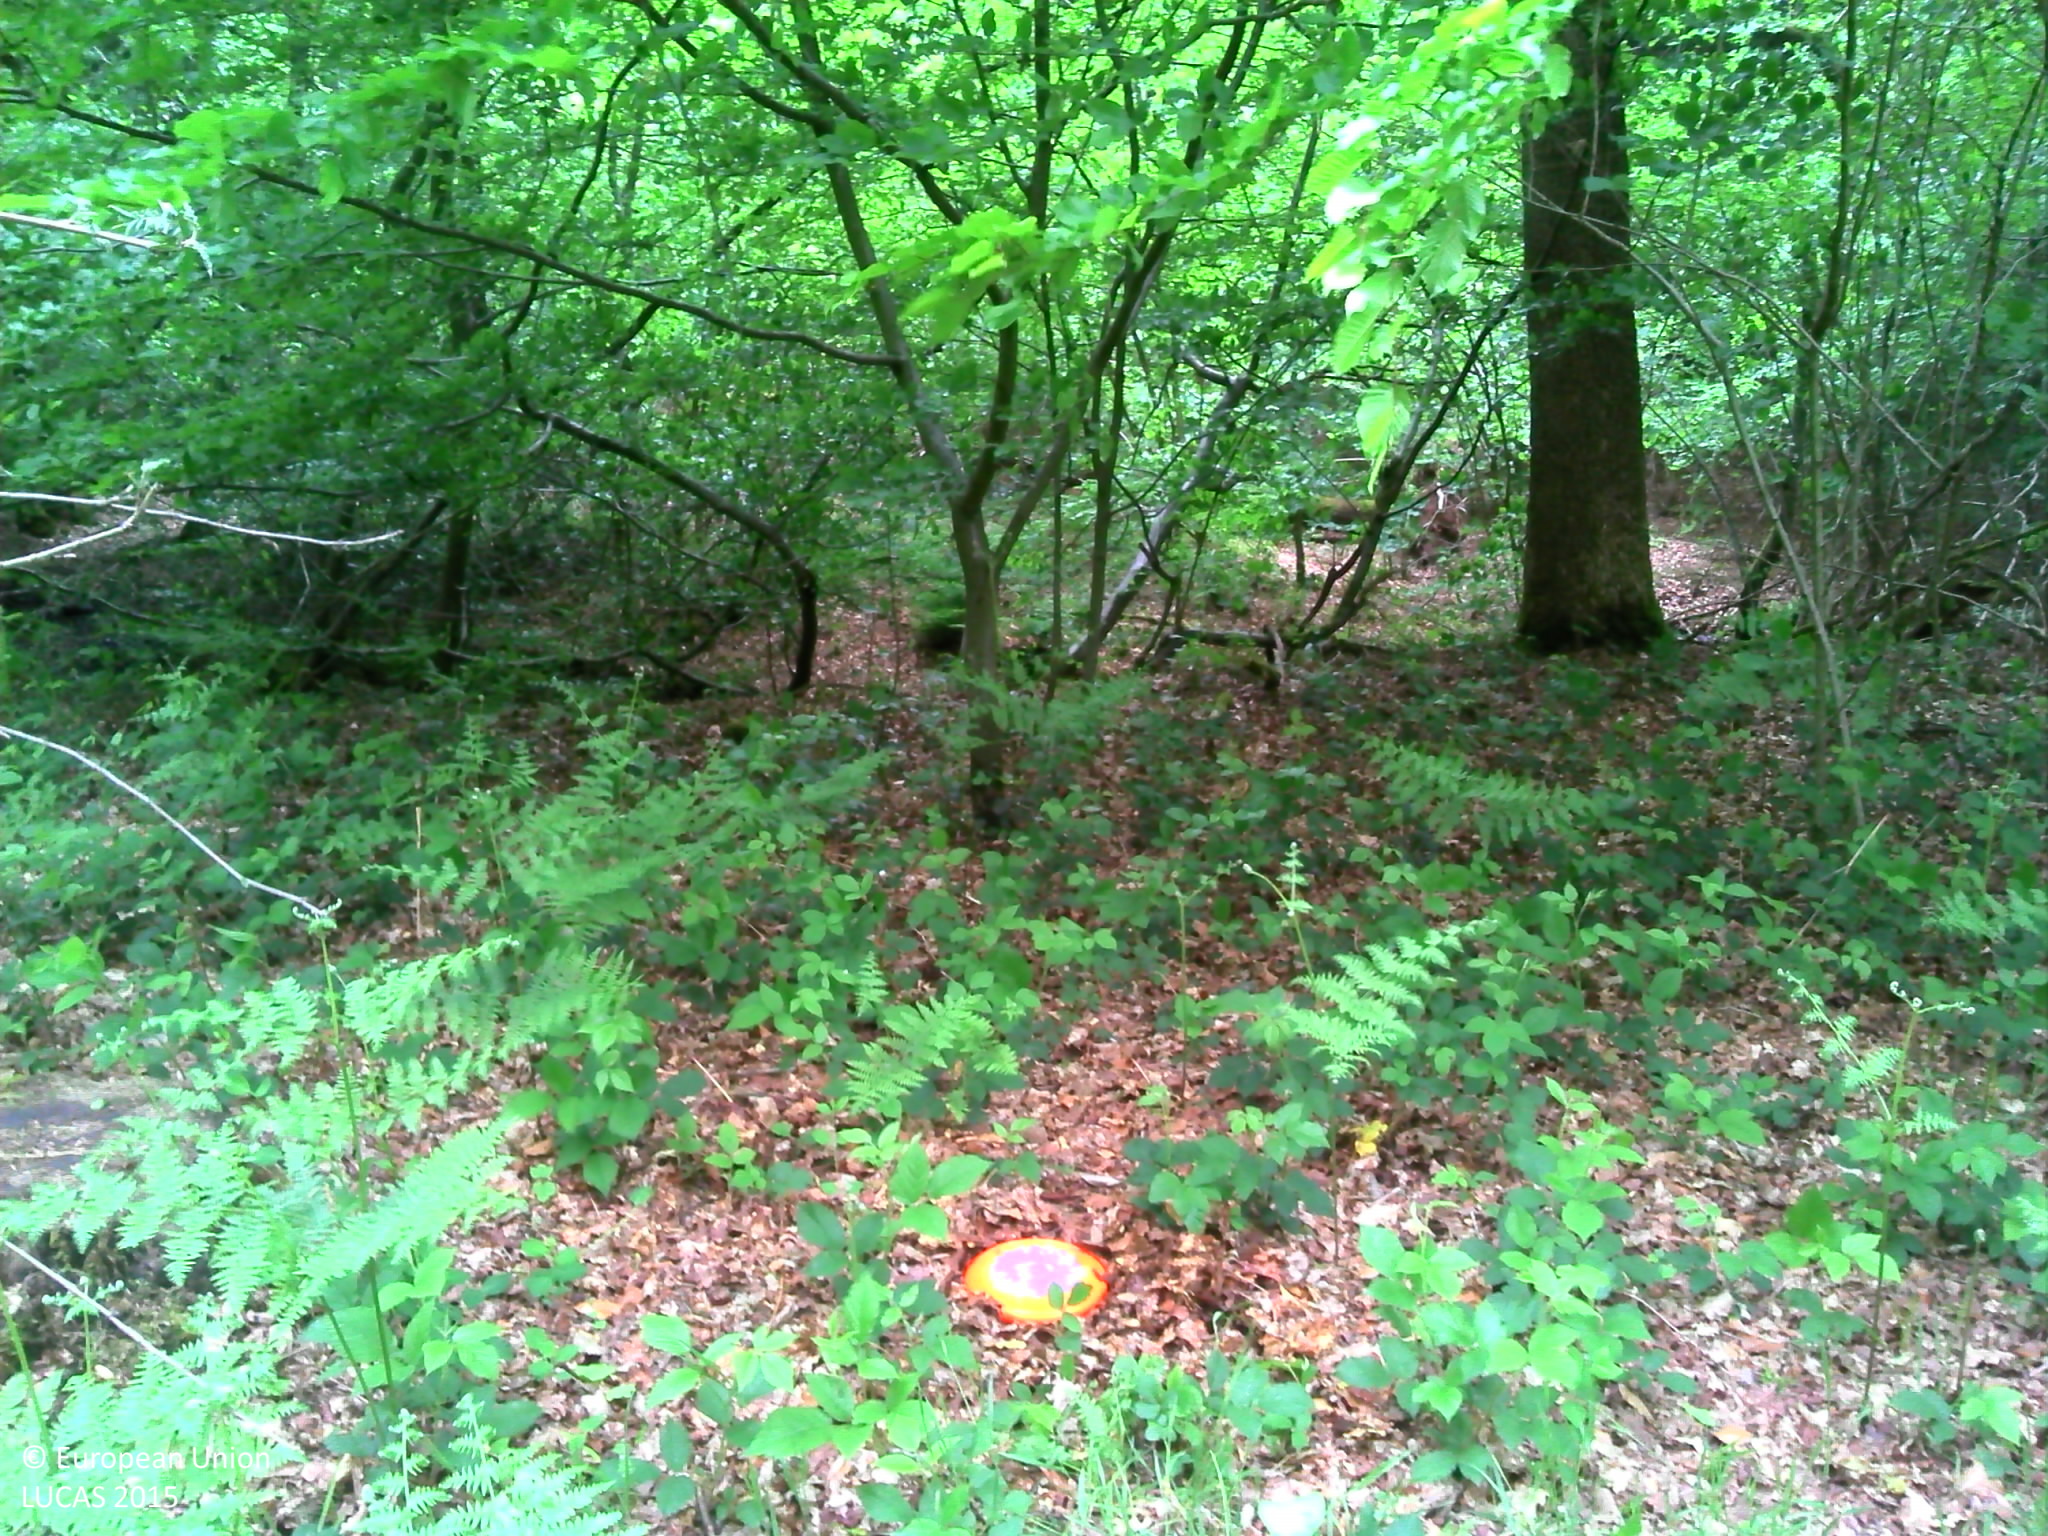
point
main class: Woodland
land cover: Broadleaved woodland
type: mesophytic deciduous forest
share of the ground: > 75 %
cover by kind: broadleaved forest trees 90 %, herbaceous plants 10 %
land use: Forestry
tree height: > 5 m
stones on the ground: < 10 %
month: June
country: BE
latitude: 50.4243
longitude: 5.6209
